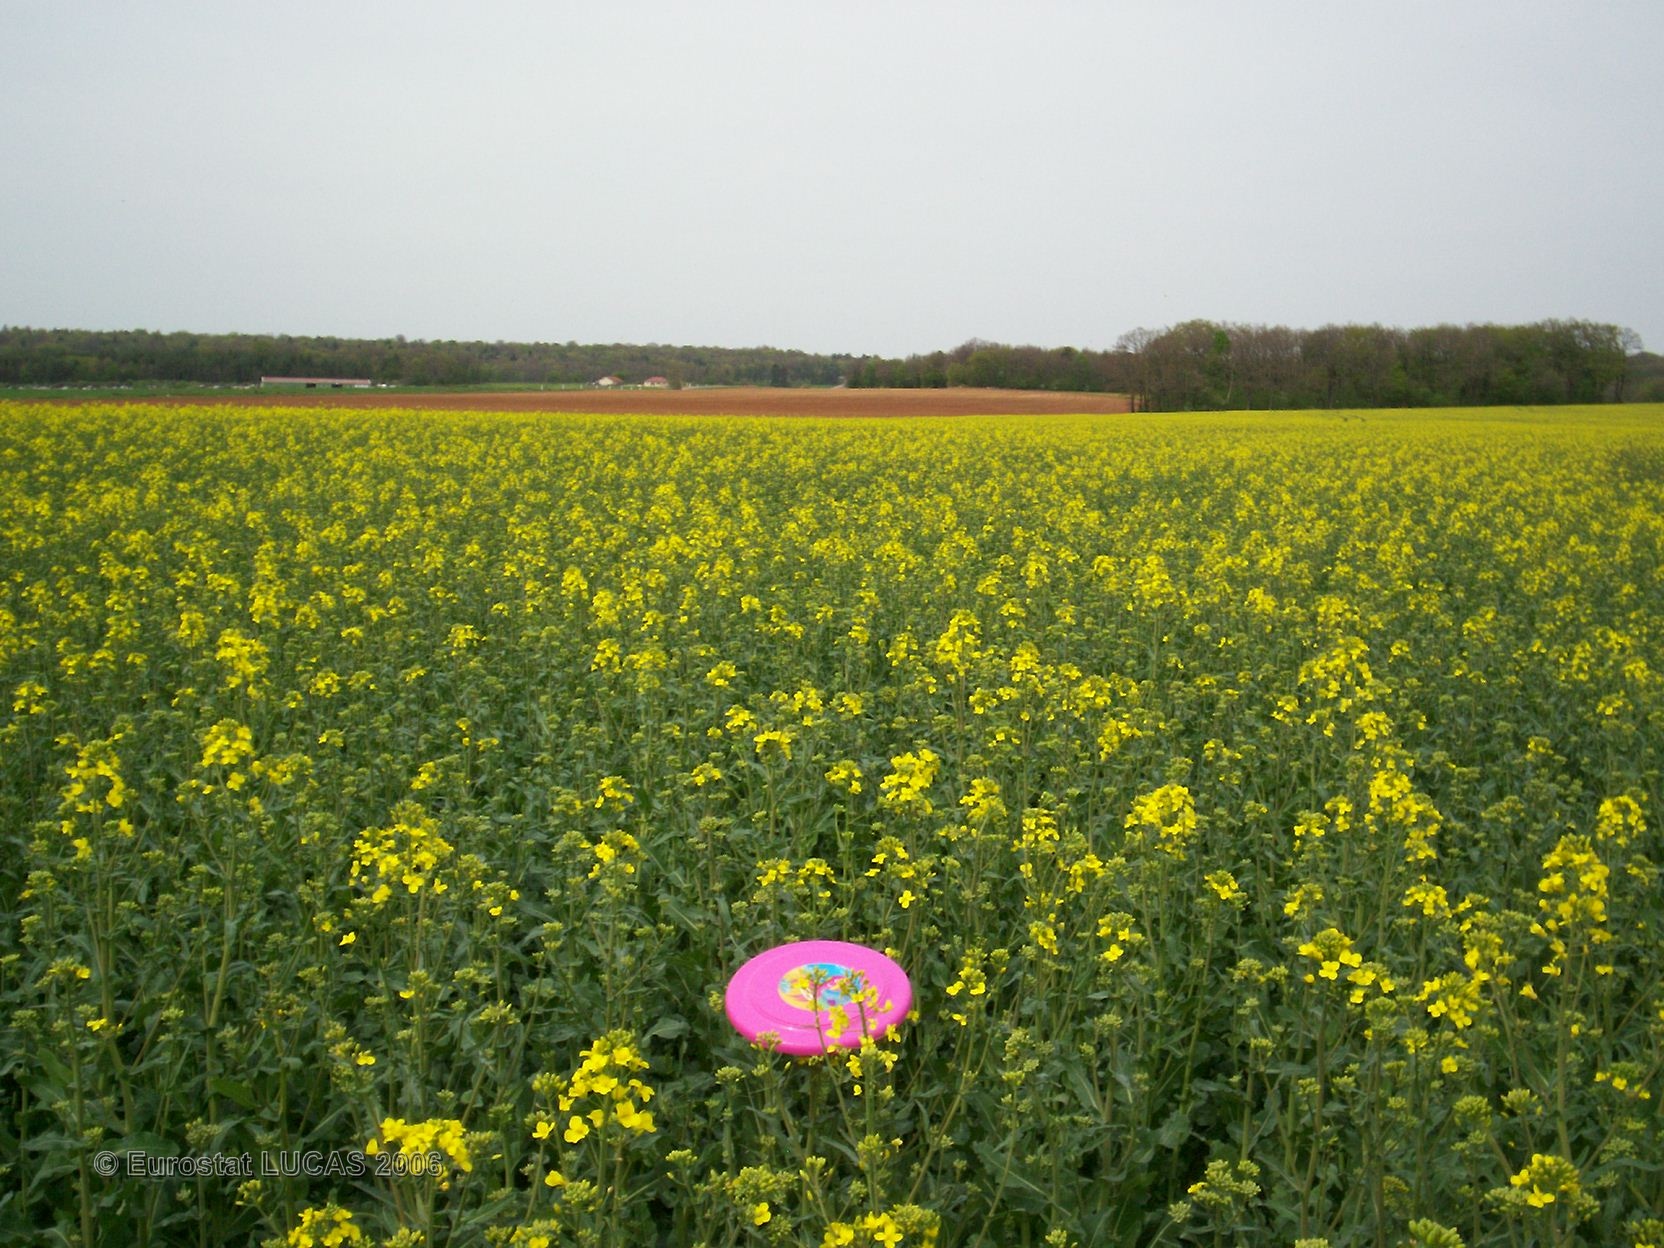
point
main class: Cropland
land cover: Rape and turnip rape
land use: Agriculture (excluding fallow land and kitchen gardens)
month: May
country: FR
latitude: 47.6906
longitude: 4.5228
